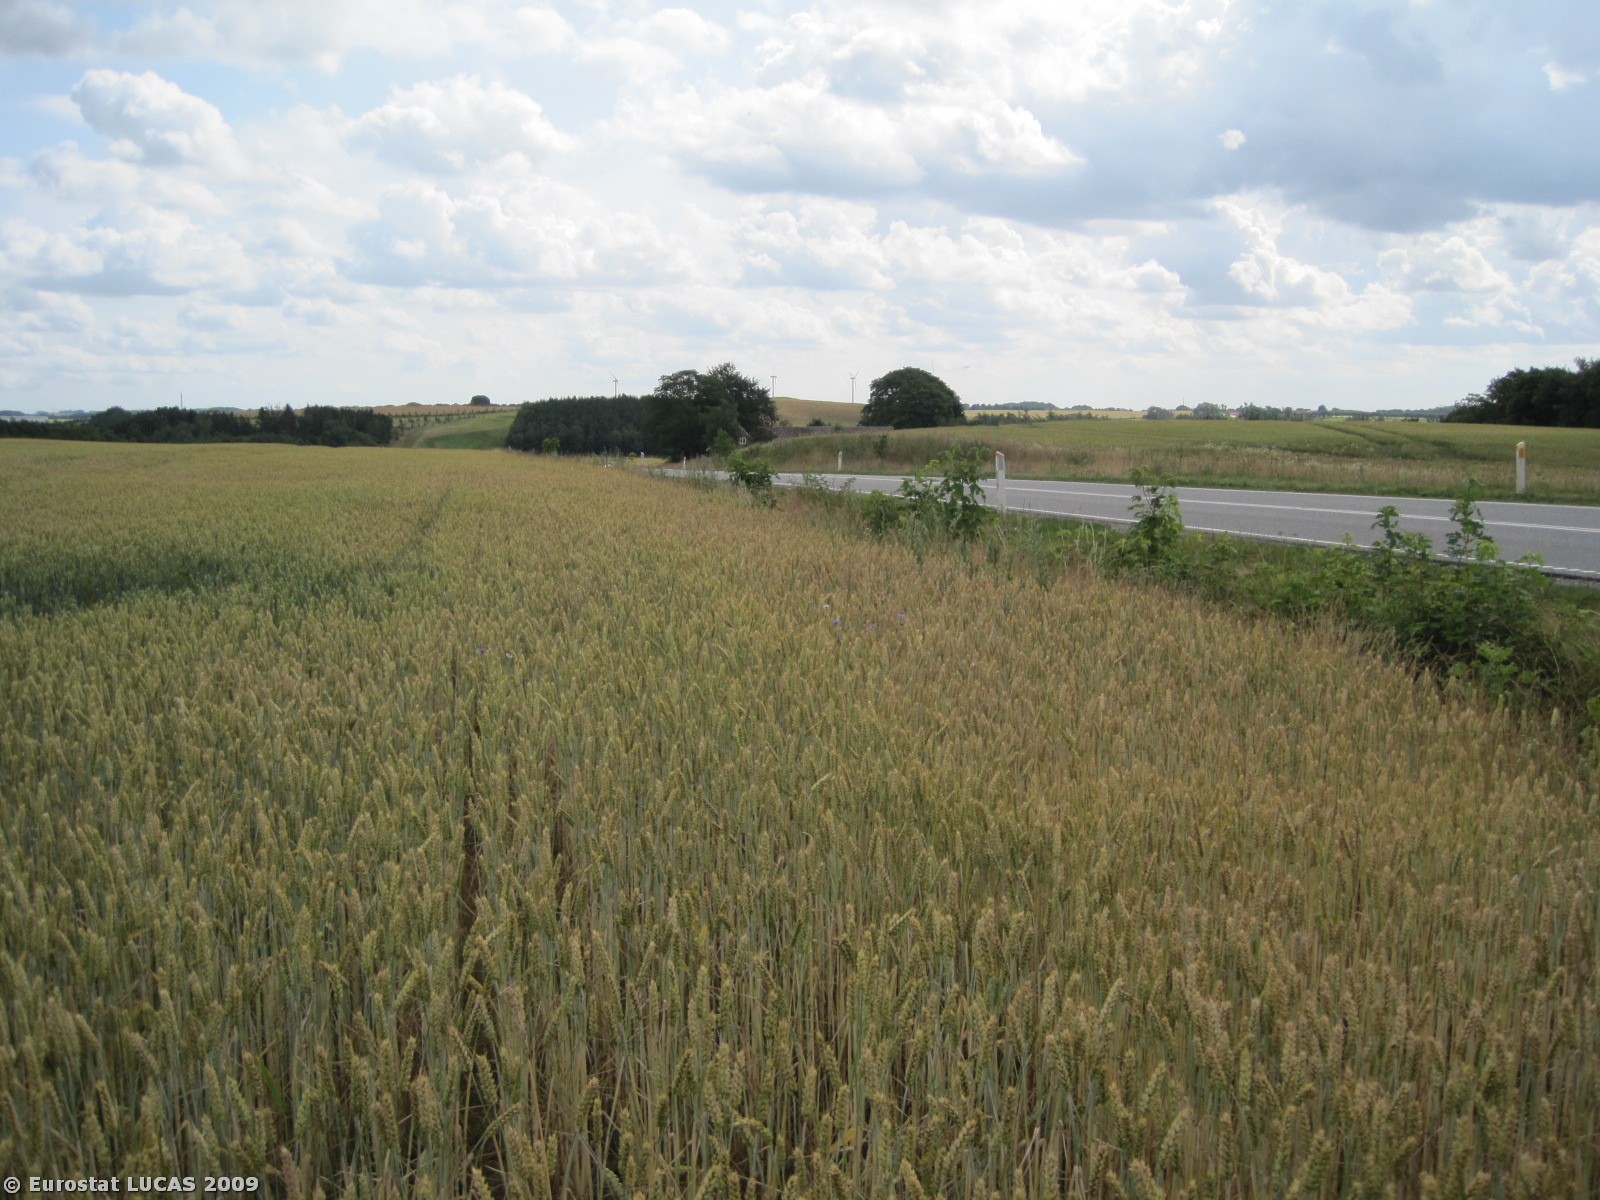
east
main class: Cropland
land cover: Common wheat
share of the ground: > 75 %
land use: Agriculture (excluding fallow land and kitchen gardens)
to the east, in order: Common wheat; Grass margins; Ditches and canals; Grassland without tree/shrub cover; Paved roads, cycling and walking lanes; Grassland without tree/shrub cover; Ditches and canals; Grass margins; Common wheat; Grass margins; Ditches and canals; Grass margins; Abandoned hedges; Grassland without tree/shrub cover; Abandoned hedges; Grassland with sparse tree/shrub cover; Artificial constructions in urban areas
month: July
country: DK
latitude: 56.6727
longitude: 9.6904
